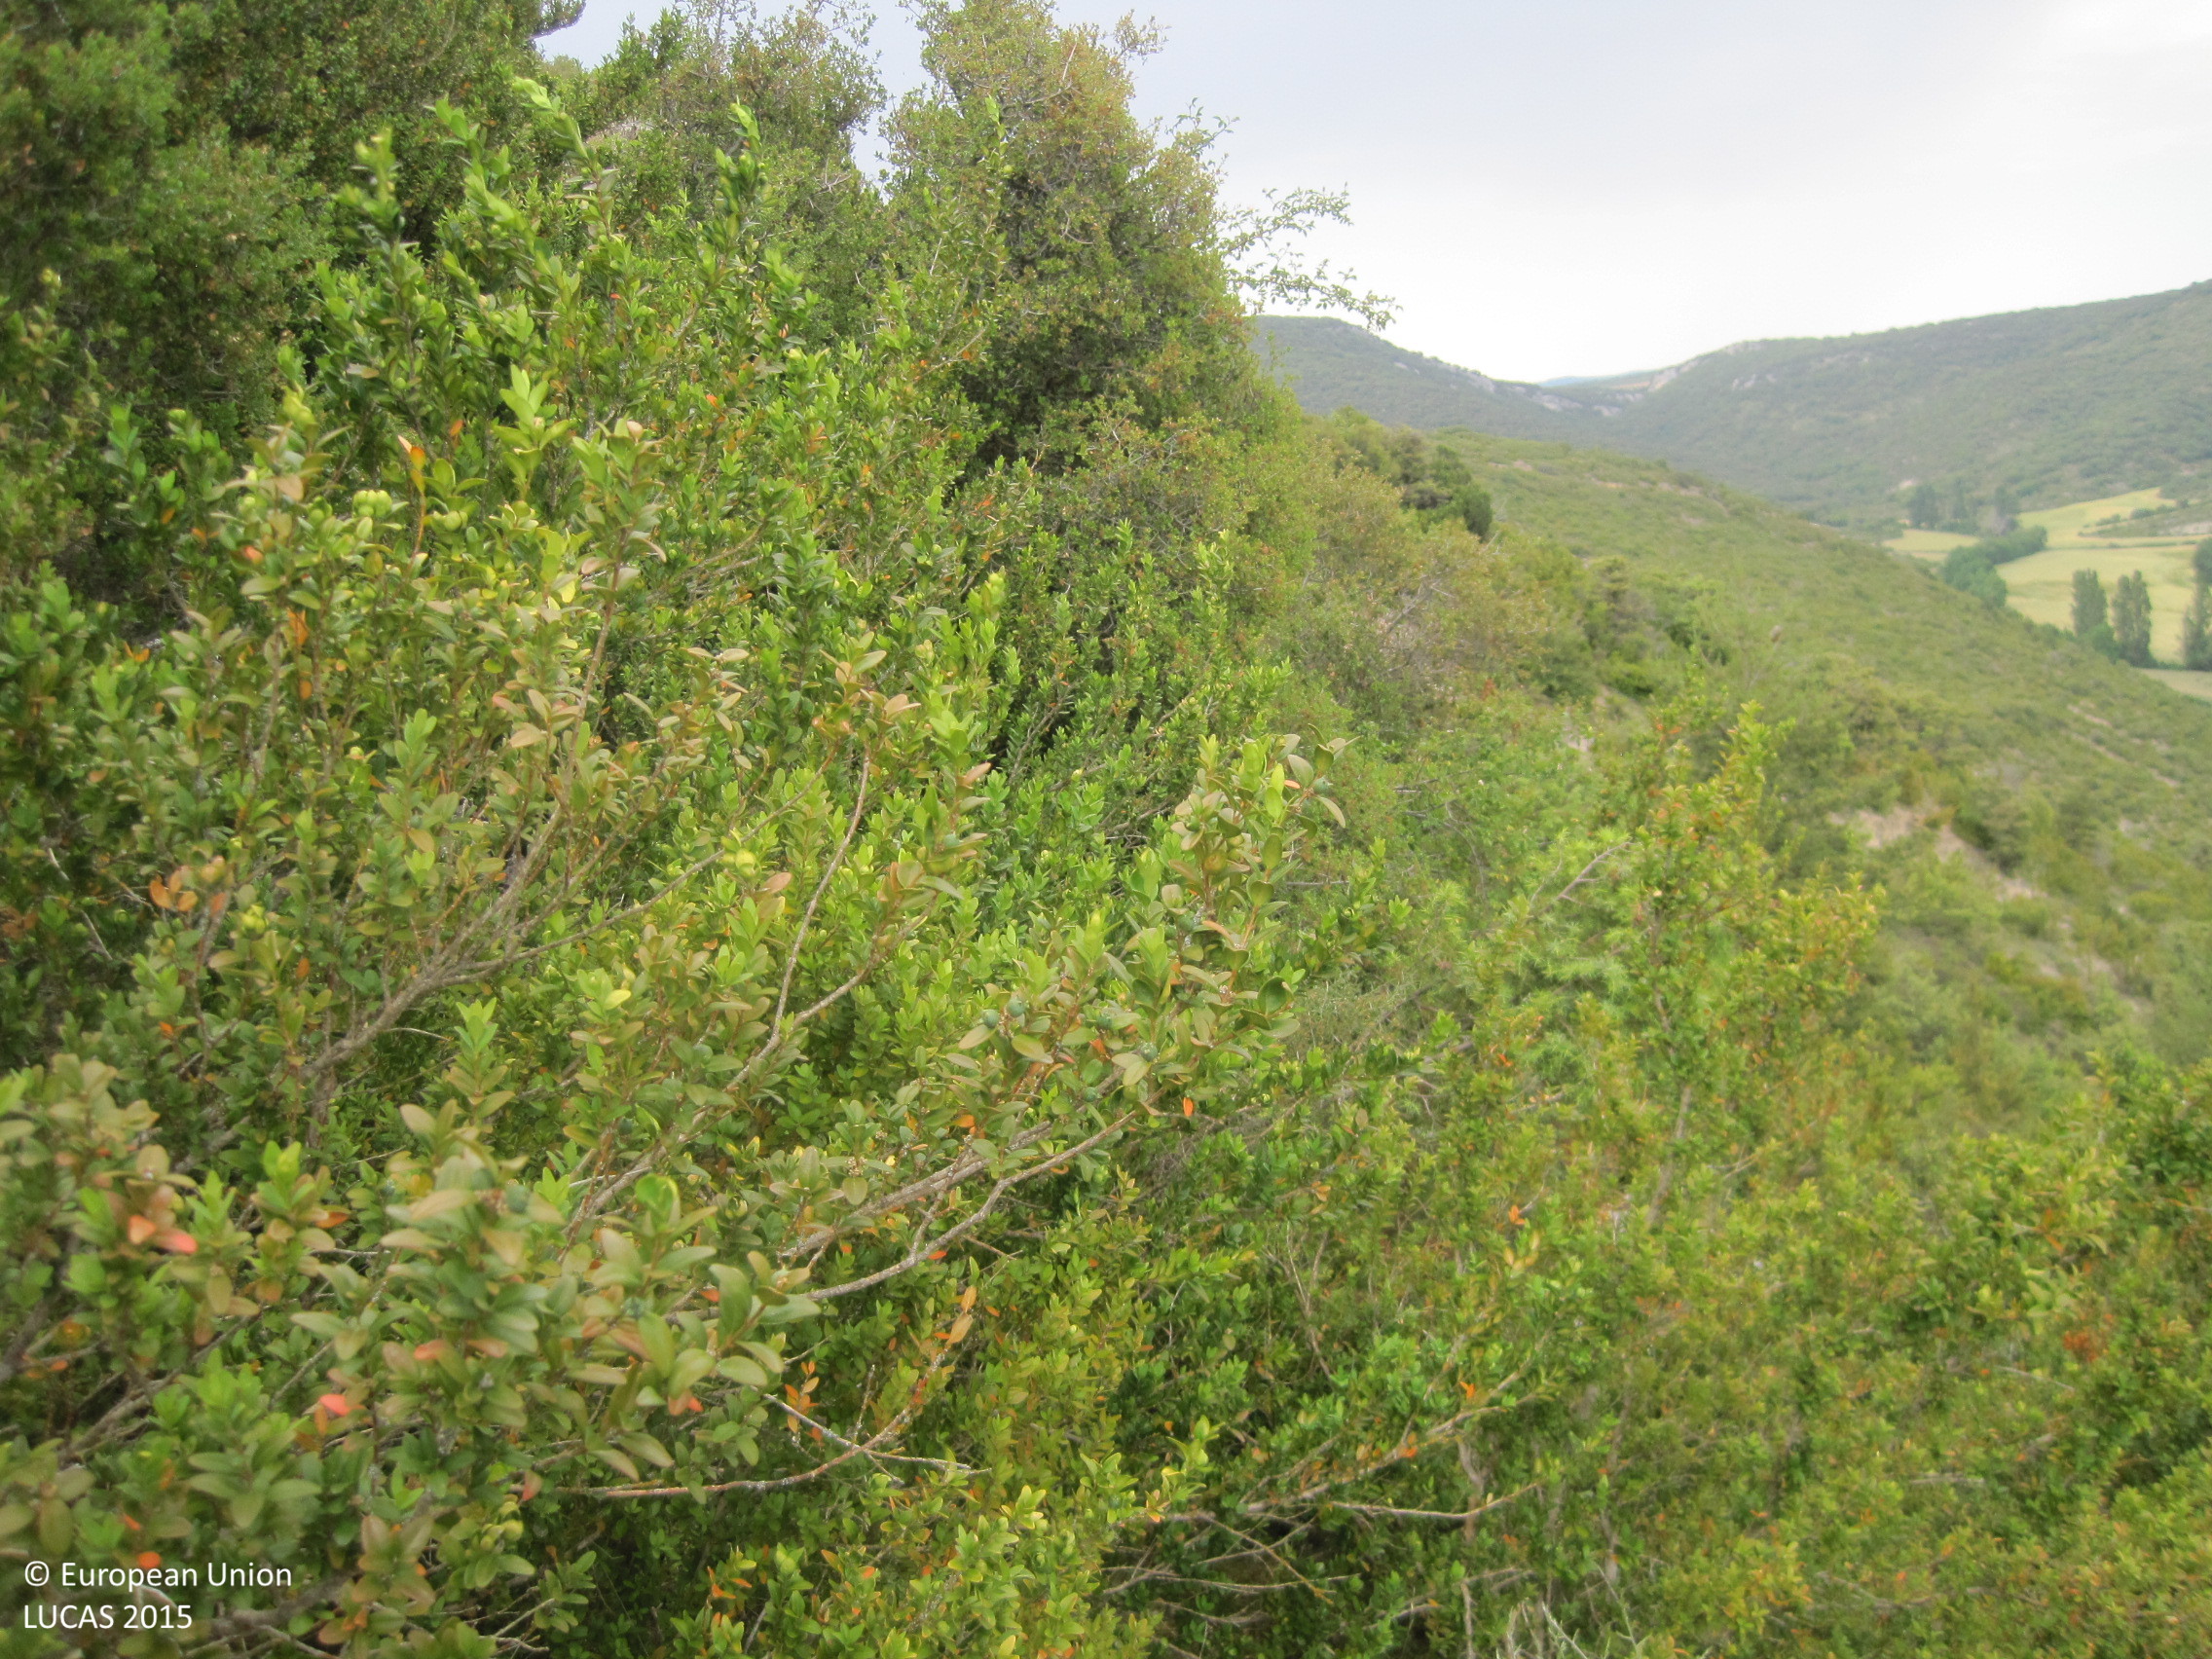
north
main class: Shrubland
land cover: Shrubland without tree cover
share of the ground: > 75 %
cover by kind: shrubs 50 %, herbaceous plants 30 %, unconsolidated bare surface 20 %
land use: Agriculture (excluding fallow land and kitchen gardens)
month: June
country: ES
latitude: 42.7015
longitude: -1.2286
